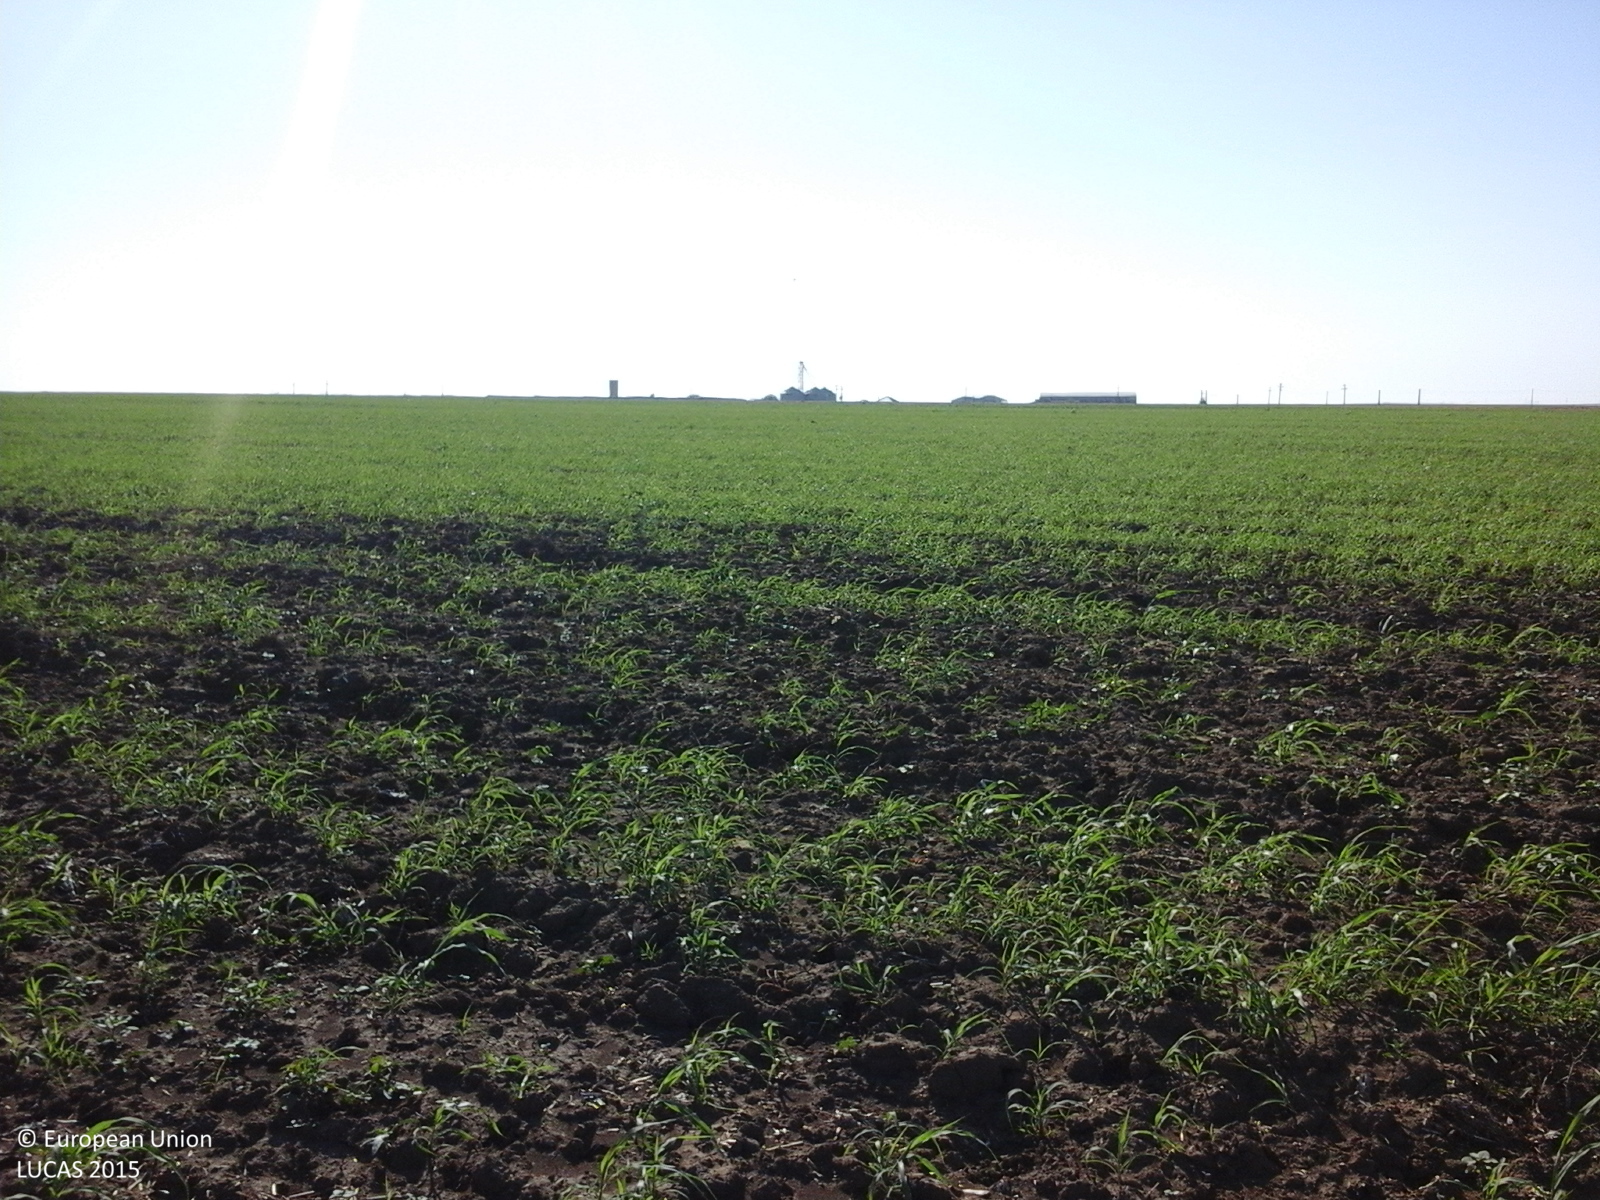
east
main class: Grassland
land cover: Spontaneously vegetated surfaces
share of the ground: > 75 %
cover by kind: herbaceous plants 100 %
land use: Agriculture (excluding fallow land and kitchen gardens)
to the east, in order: Spontaneously vegetated surfaces
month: August
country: RO
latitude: 44.5496
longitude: 28.6192
